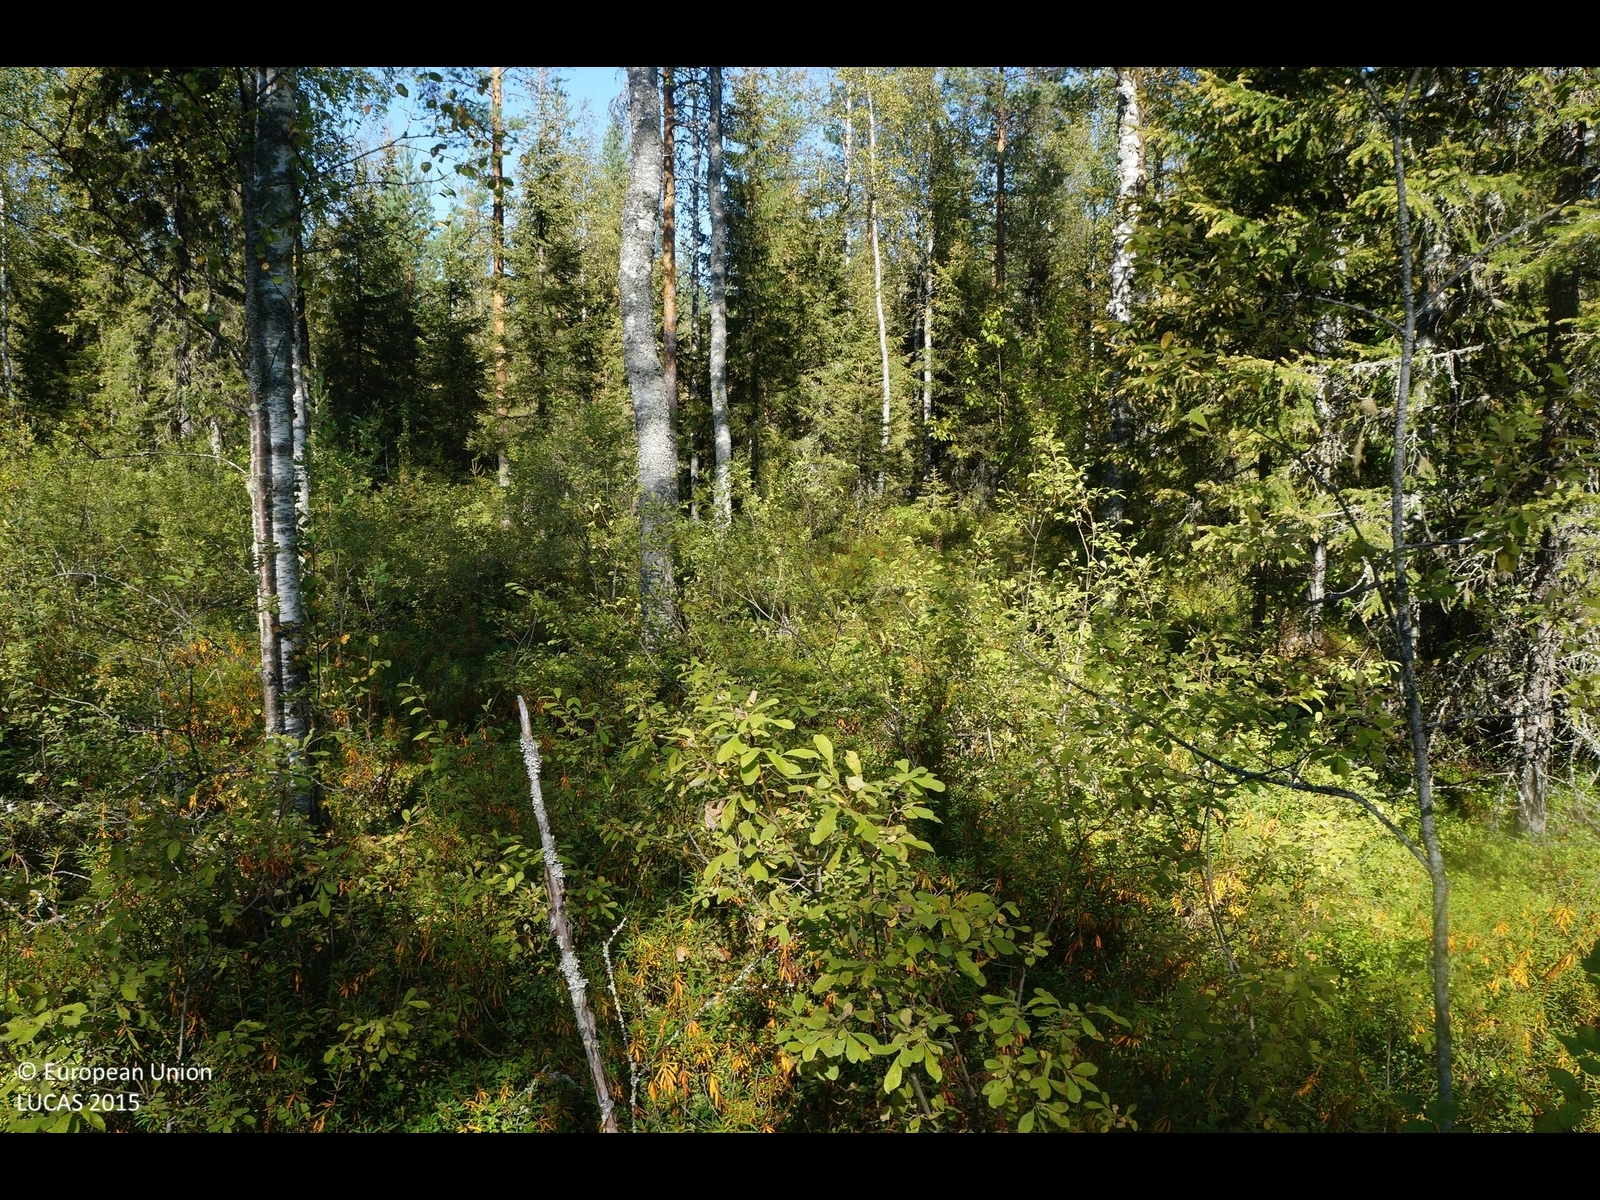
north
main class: Woodland
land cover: Other mixed woodland
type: boreal forest
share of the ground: 50 - 75 %
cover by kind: coniferous forest trees 30 %, shrubs 30 %, broadleaved forest trees 20 %, herbaceous plants 10 %, lichens and mosses 10 %
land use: Forestry
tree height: > 5 m
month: August
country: FI
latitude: 64.4020
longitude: 25.1648
